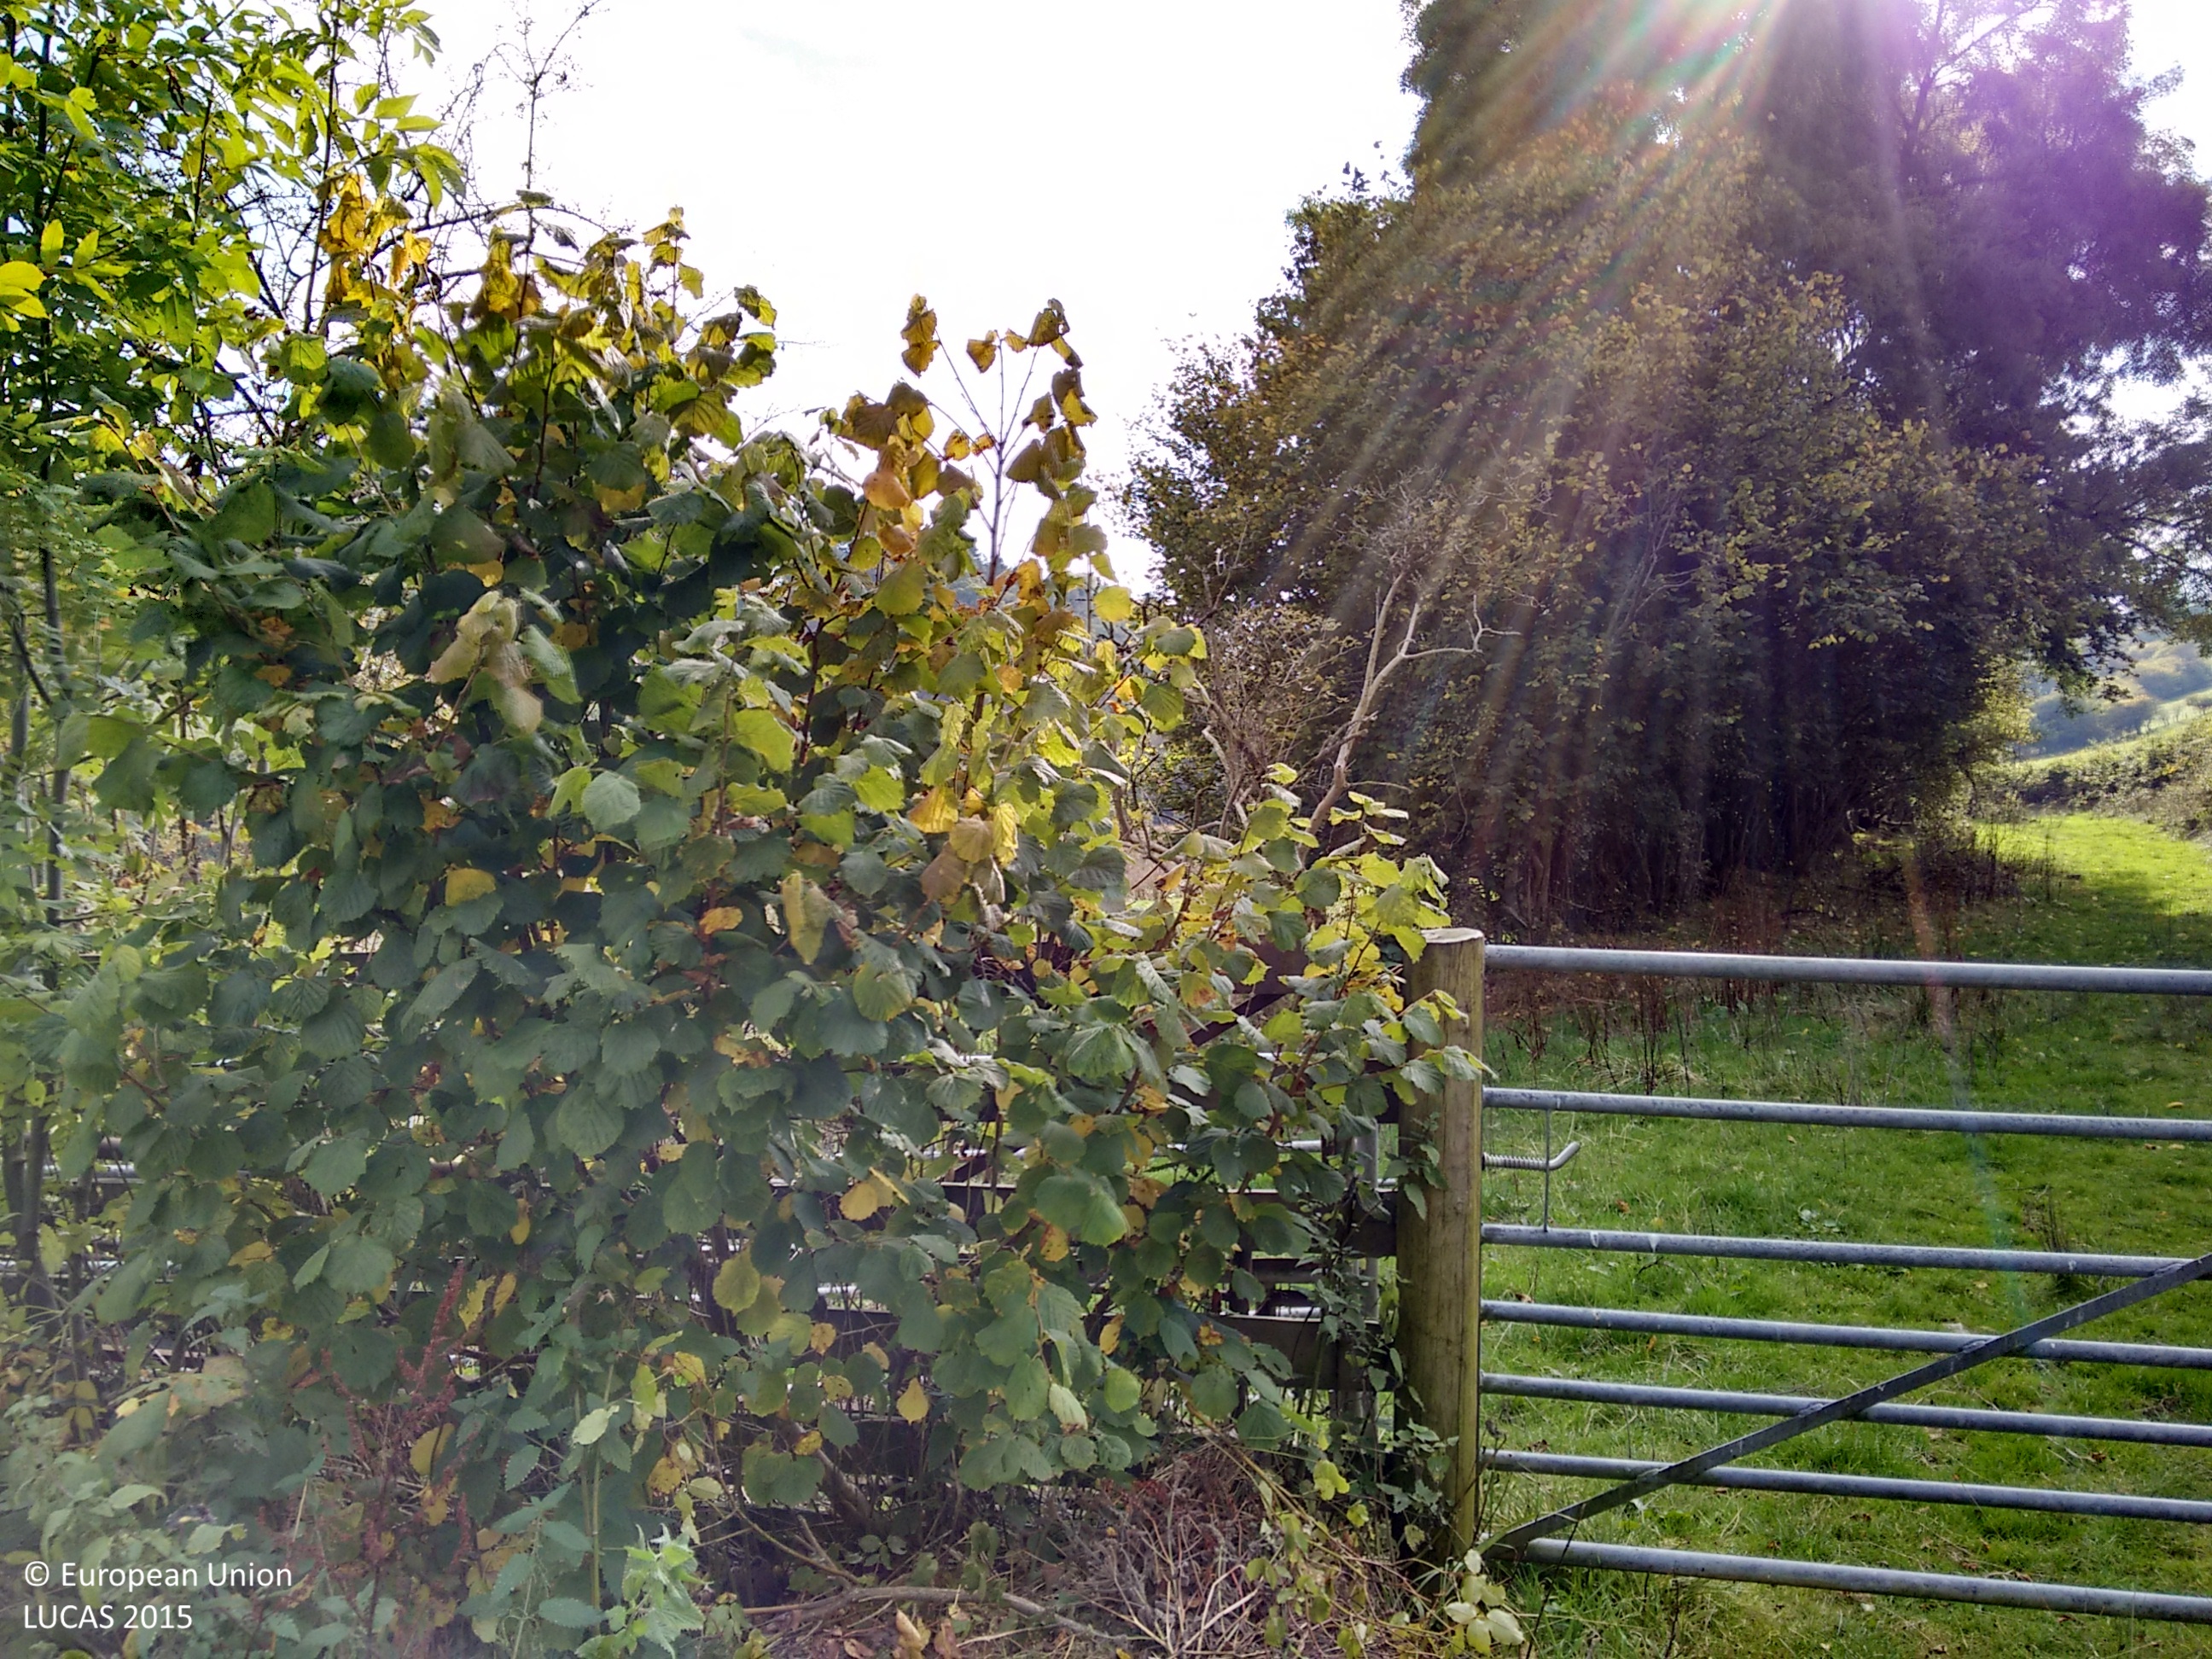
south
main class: Woodland
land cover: Broadleaved woodland
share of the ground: > 75 %
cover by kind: broadleaved forest trees 60 %, herbaceous plants 40 %
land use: Residential
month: October
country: GB
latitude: 52.4147
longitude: -3.5677
